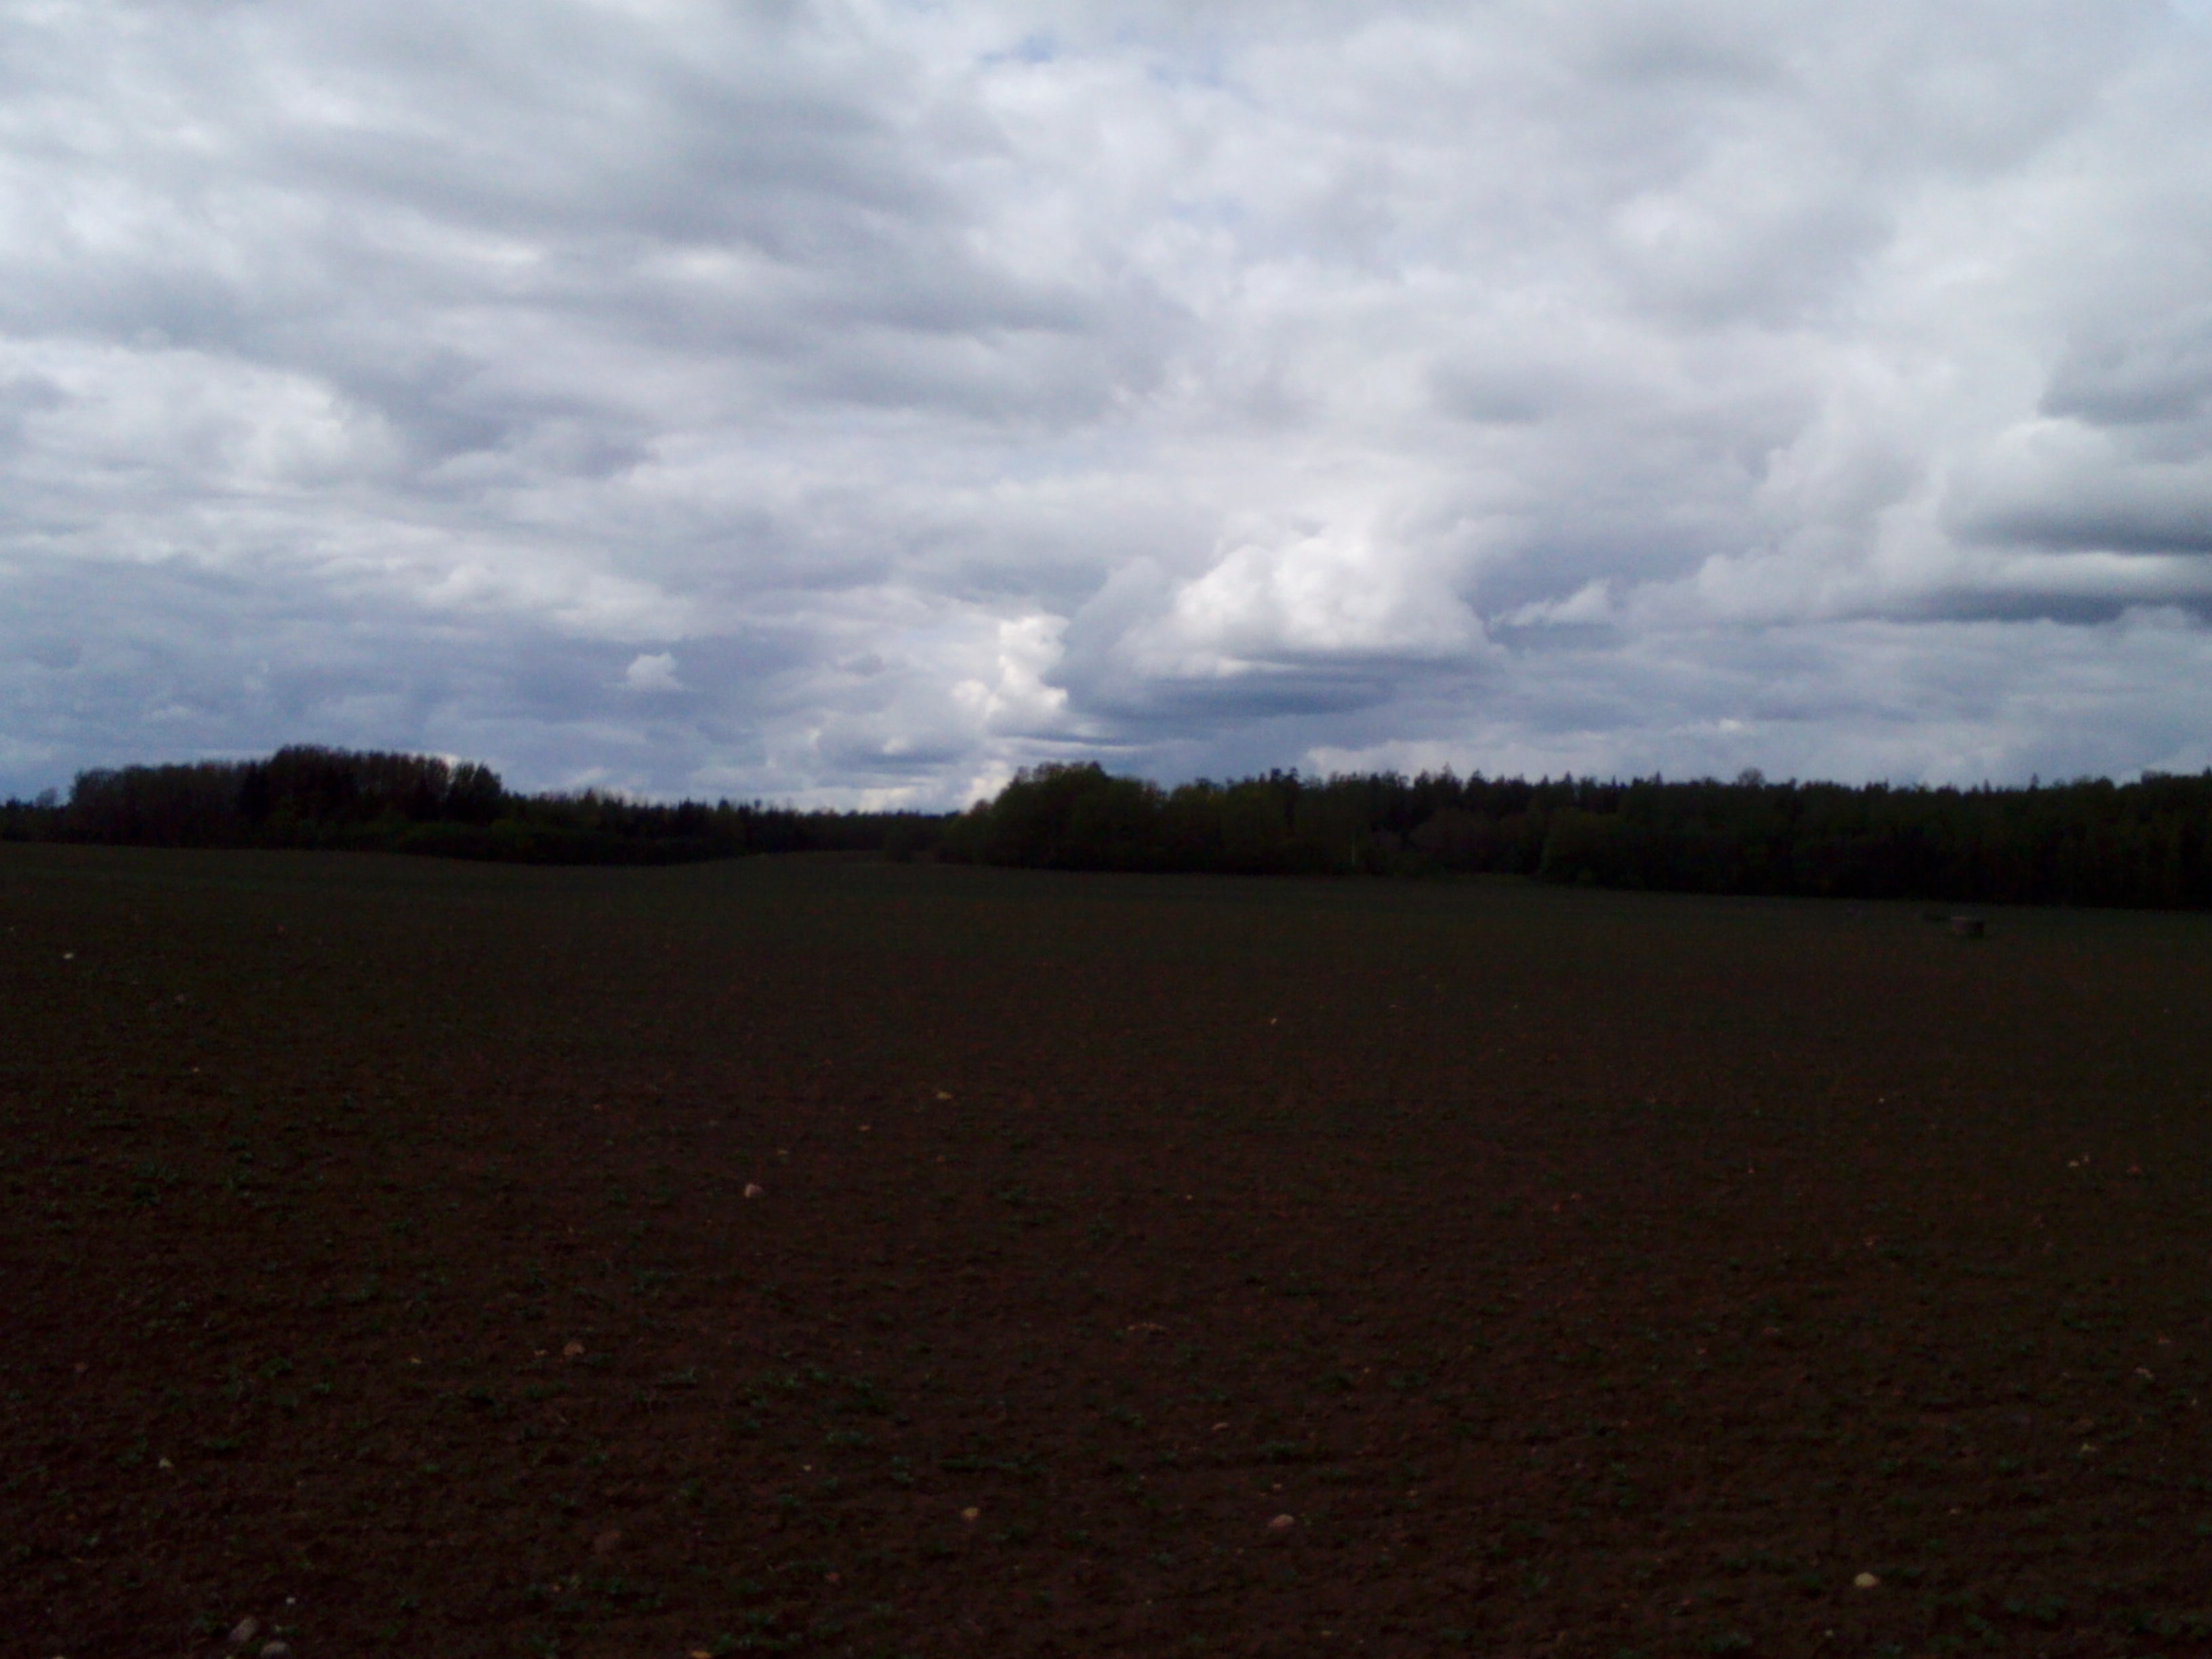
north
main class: Cropland
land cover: Dry pulses
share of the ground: 10 - 25 %
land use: Agriculture (excluding fallow land and kitchen gardens)
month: May
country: LV
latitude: 56.7581
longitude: 22.8697
